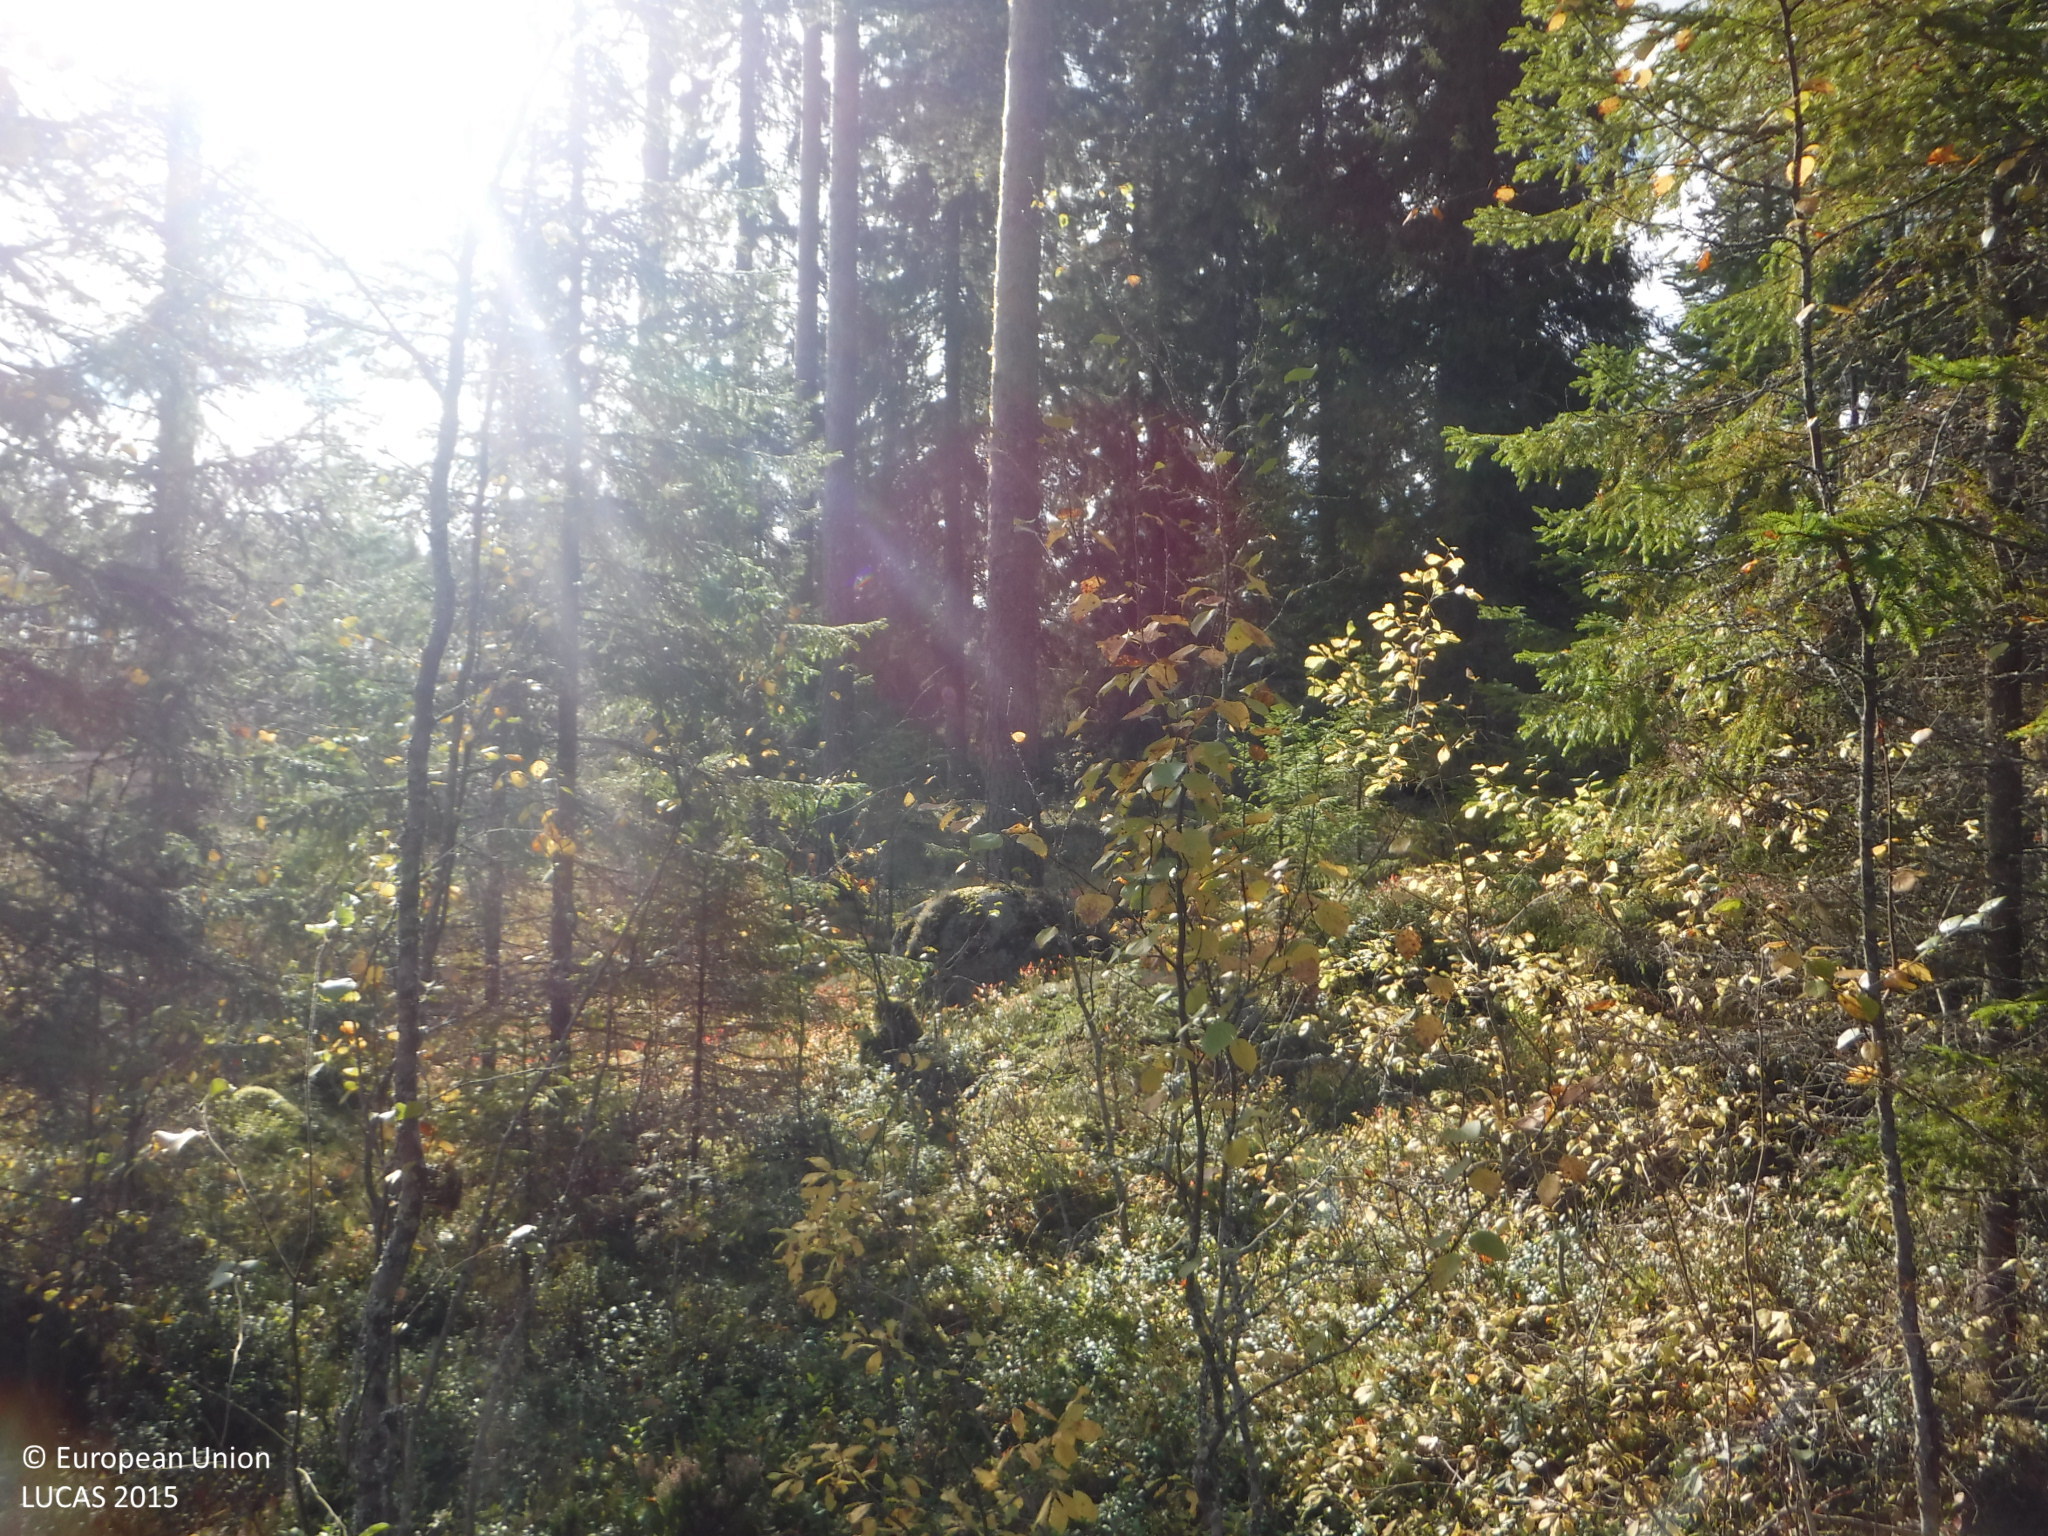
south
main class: Woodland
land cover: Other coniferous woodland
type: boreal forest
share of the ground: 25 - 50 %
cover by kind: shrubs 45 %, coniferous forest trees 30 %, lichens and mosses 25 %
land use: Forestry
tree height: > 5 m
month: September
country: FI
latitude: 61.5926
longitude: 24.1281
